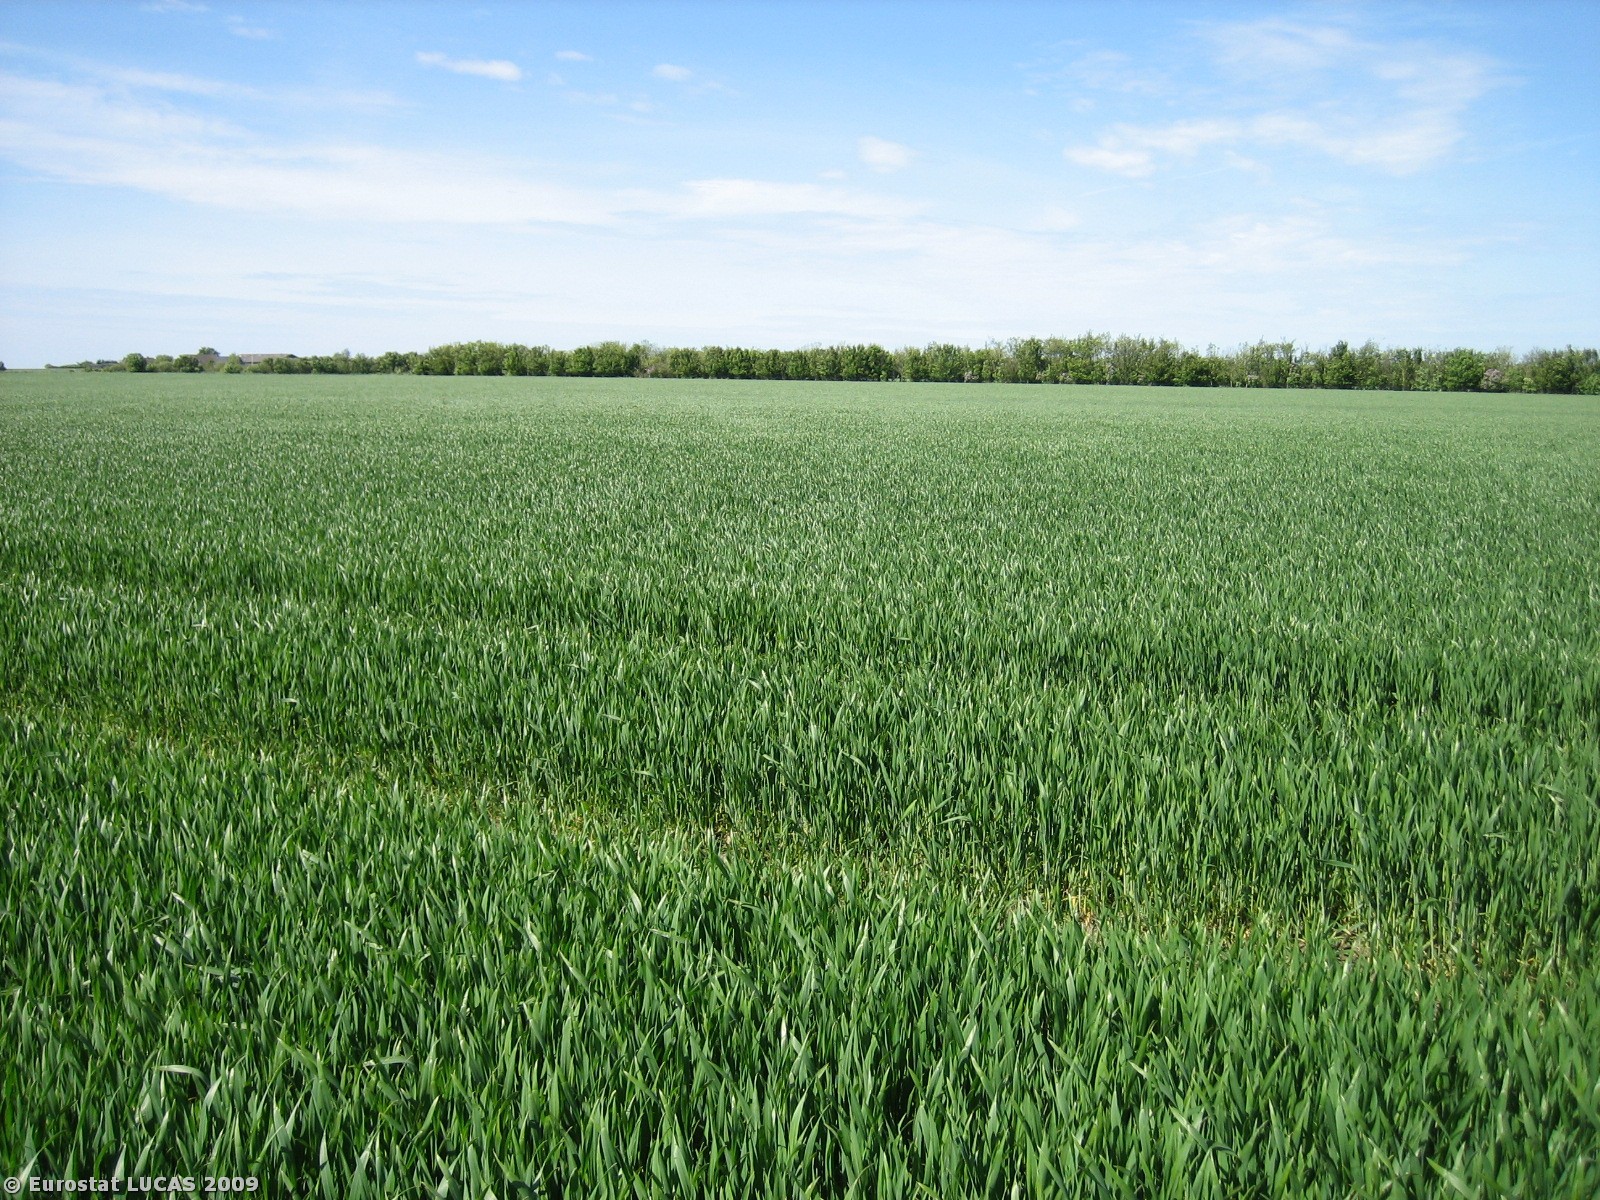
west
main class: Cropland
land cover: Common wheat
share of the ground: > 75 %
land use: Agriculture (excluding fallow land and kitchen gardens)
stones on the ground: < 10 %
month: May
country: DK
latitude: 55.9443
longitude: 8.4165
